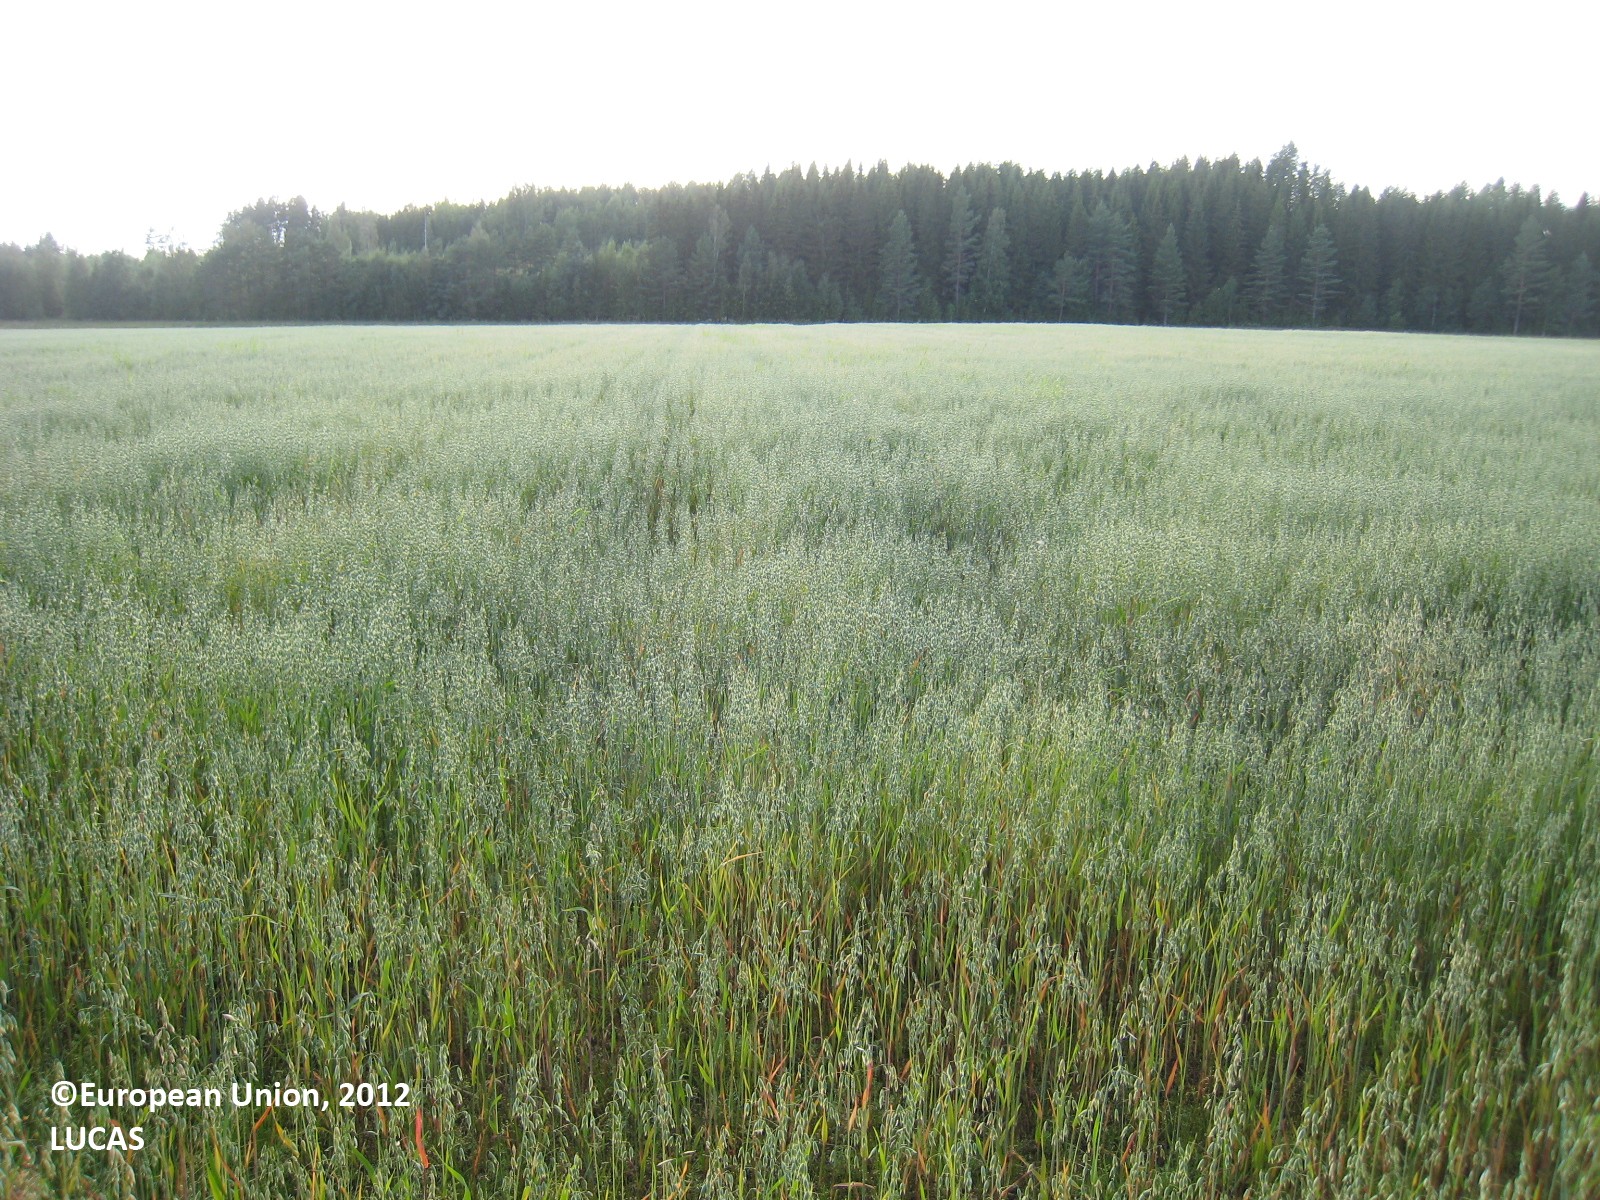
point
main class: Cropland
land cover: Oats
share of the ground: 50 - 75 %
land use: Agriculture (excluding fallow land and kitchen gardens)
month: July
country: FI
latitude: 61.6720
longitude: 26.0201
